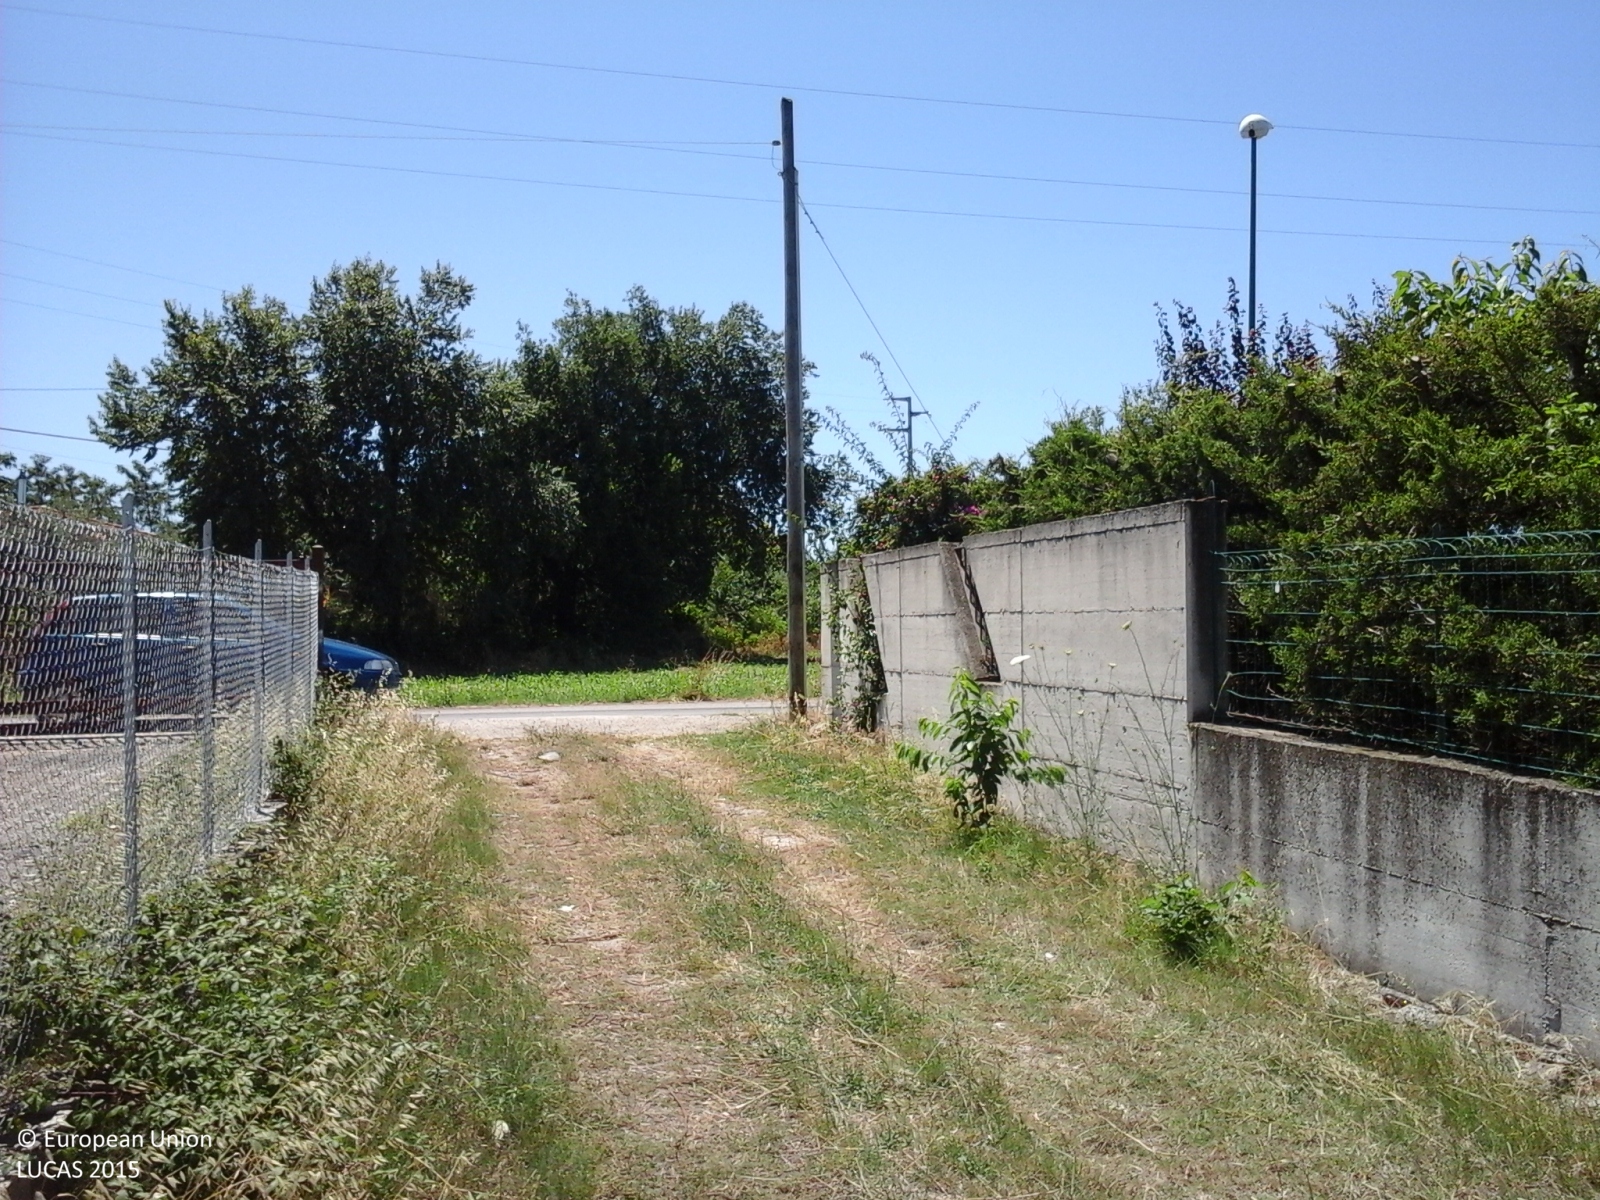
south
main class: Cropland
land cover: Other fresh vegetables
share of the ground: 50 - 75 %
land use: Agriculture (excluding fallow land and kitchen gardens)
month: June
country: IT
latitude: 40.4642
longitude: 15.0379
